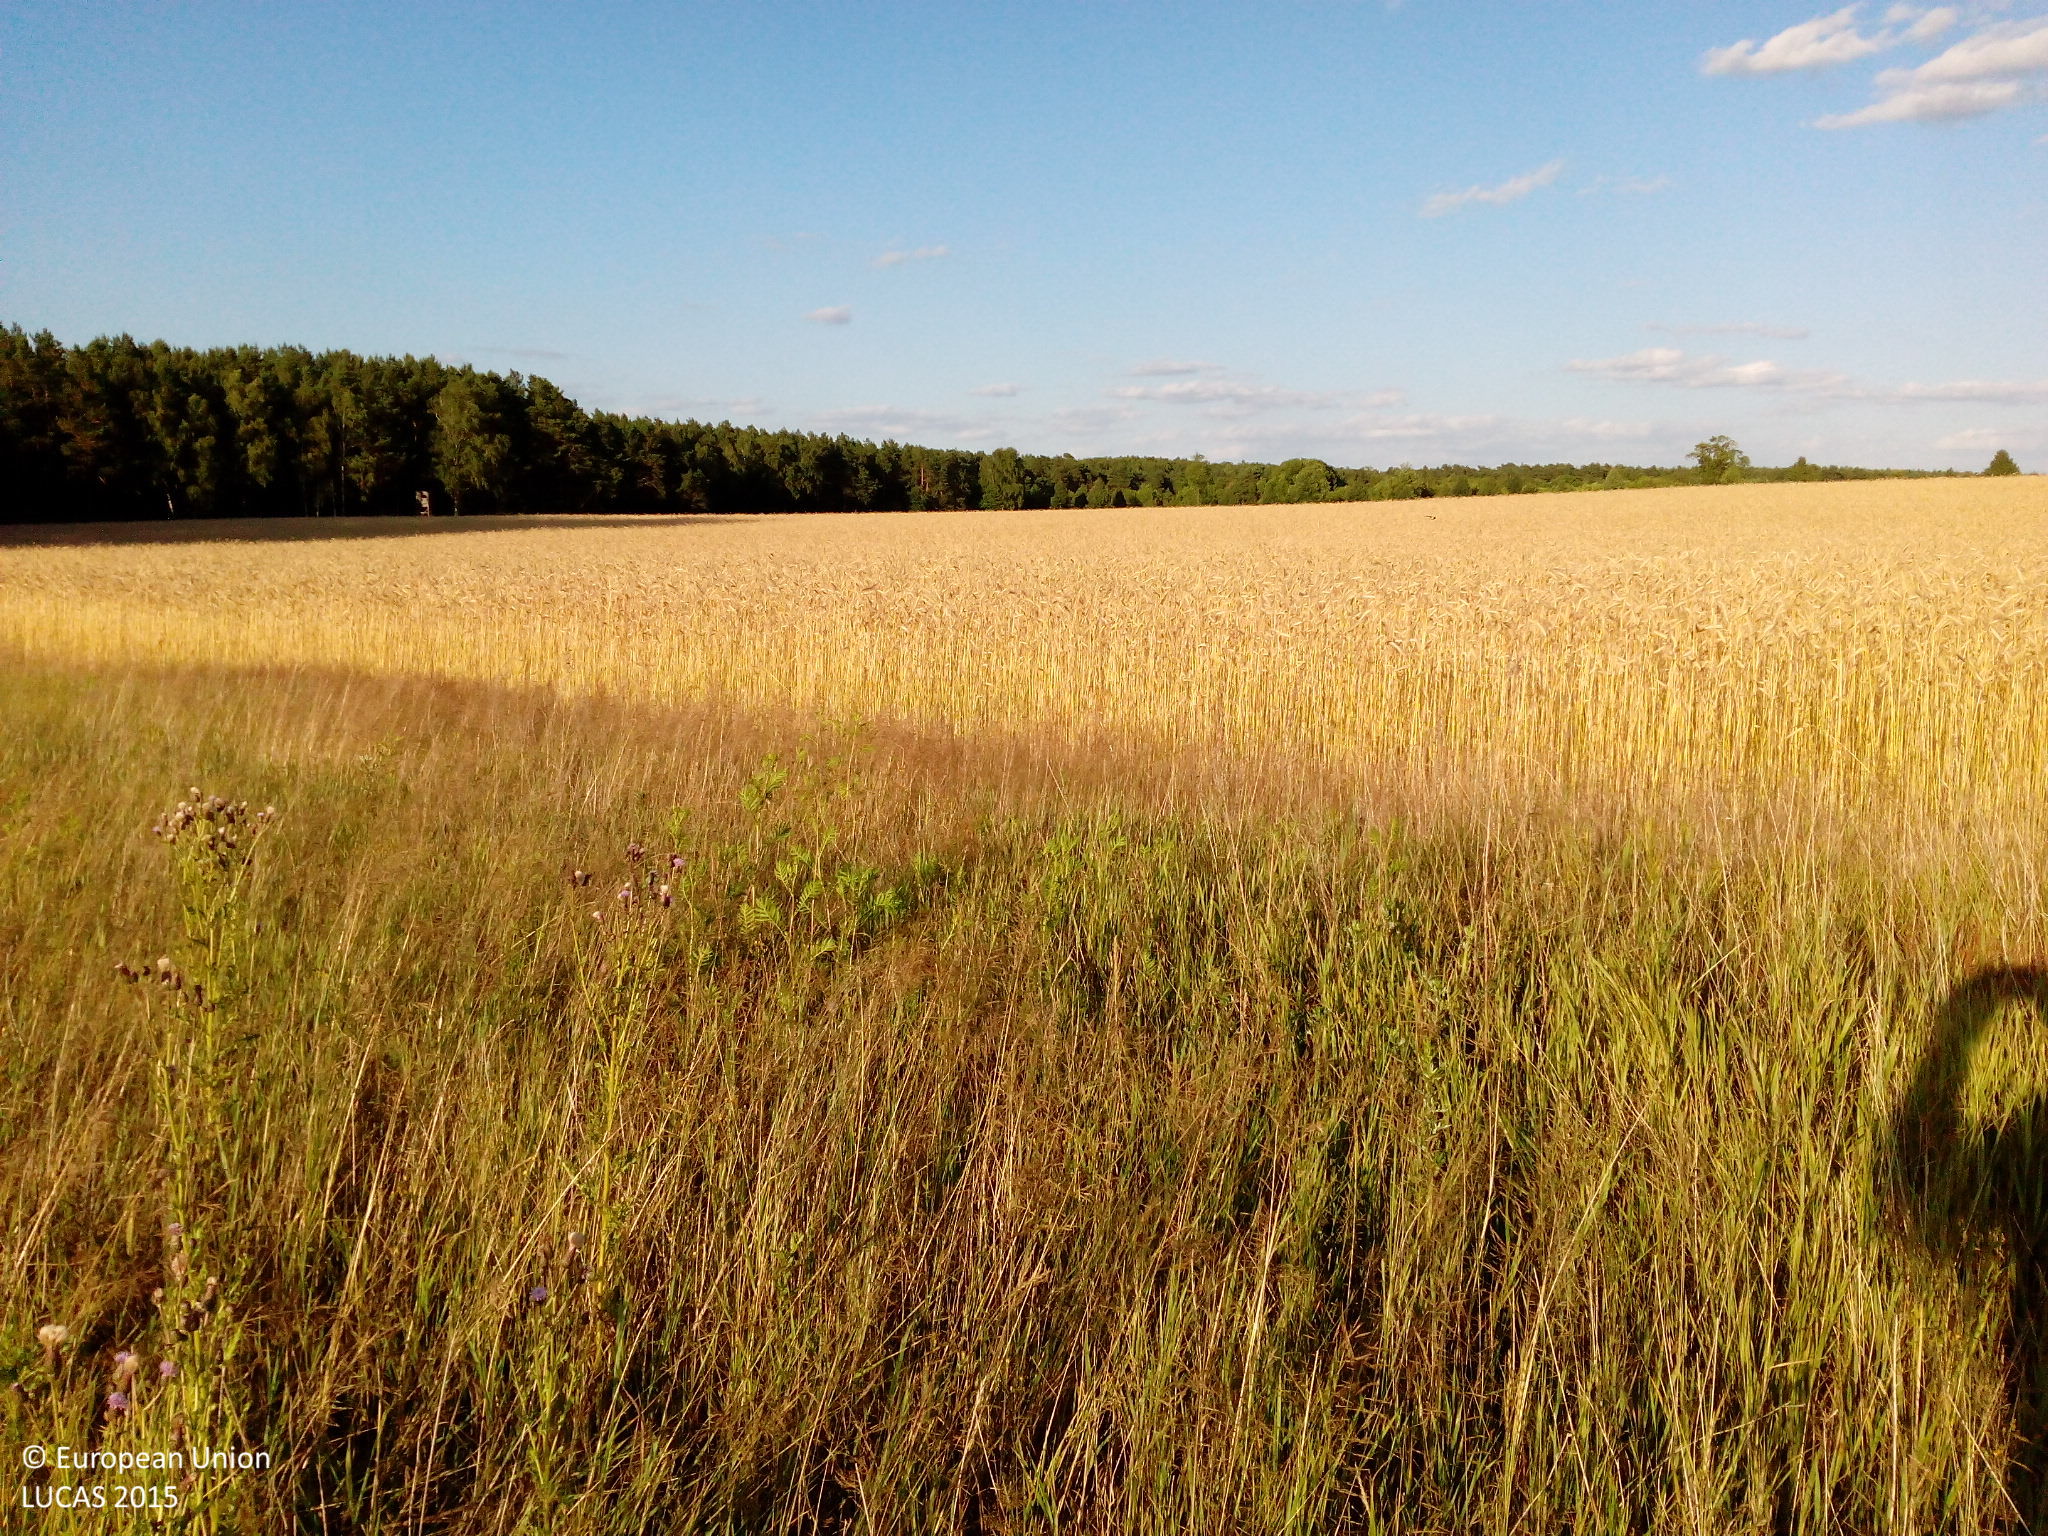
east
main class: Grassland
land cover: Grassland without tree/shrub cover
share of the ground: > 75 %
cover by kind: herbaceous plants 100 %
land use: Forestry
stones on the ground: < 10 %
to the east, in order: Grassland without tree/shrub cover; Grassland with sparse tree/shrub cover; Fences; Grassland without tree/shrub cover; Rye
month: July
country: DE
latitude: 52.7359
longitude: 13.6288
